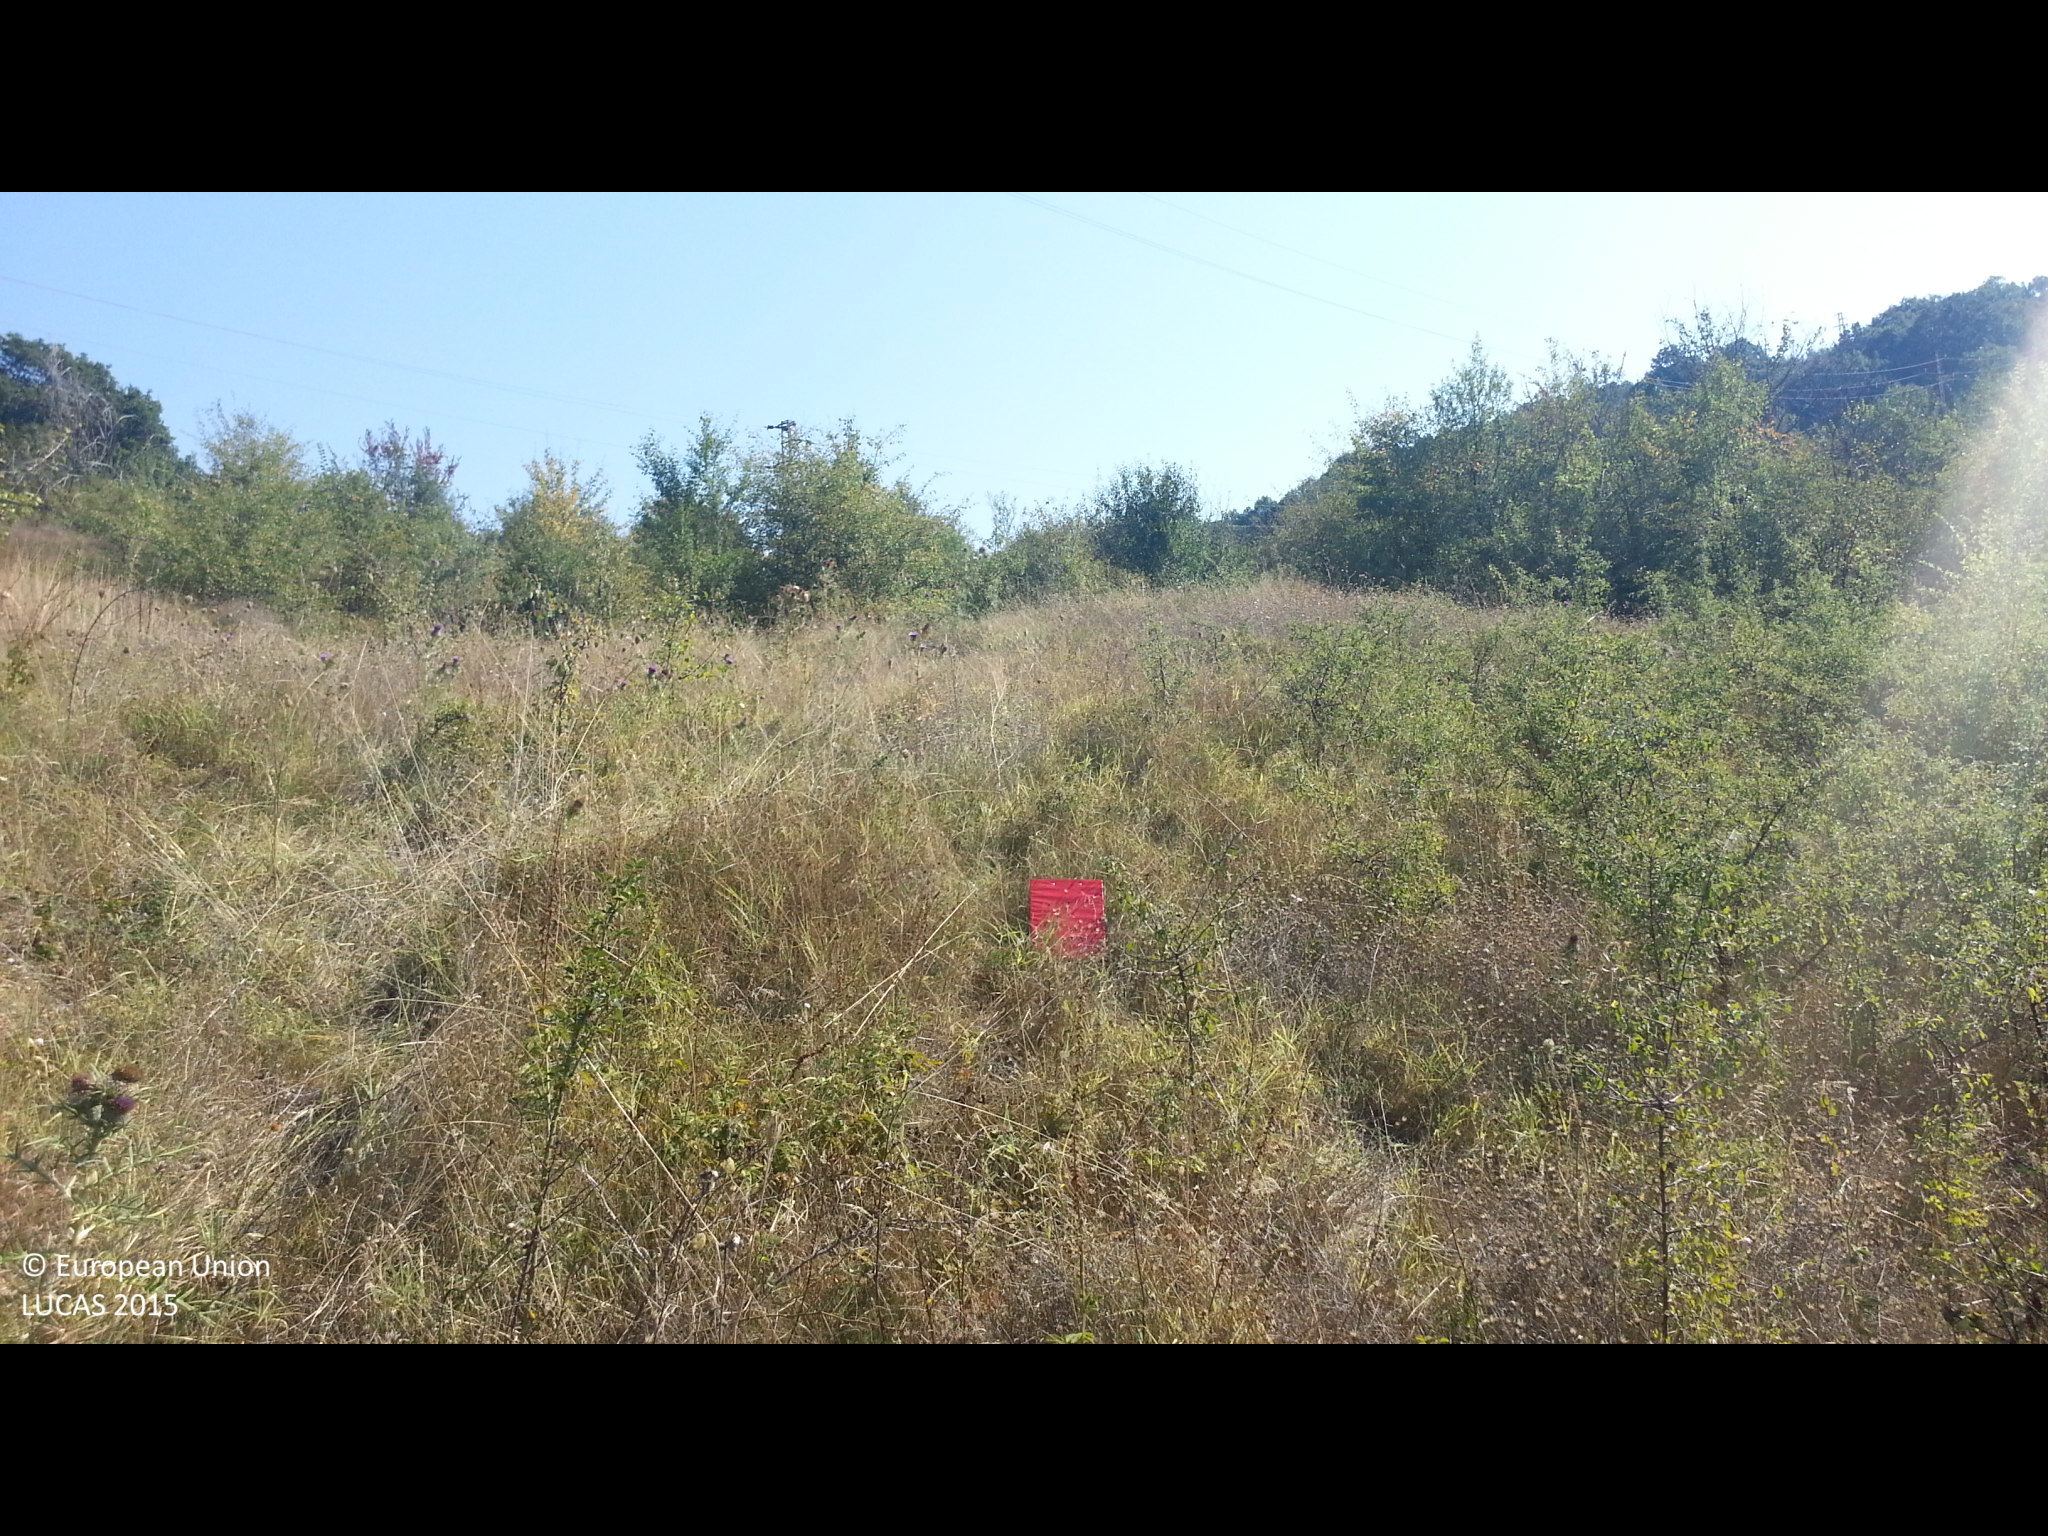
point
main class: Grassland
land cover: Grassland with sparse tree/shrub cover
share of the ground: > 75 %
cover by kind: herbaceous plants 95 %, broadleaved forest trees 5 %
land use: Semi-natural and natural areas not in use
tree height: < 5 m
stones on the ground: < 10 %
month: September
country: BG
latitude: 42.3805
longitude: 22.9856
